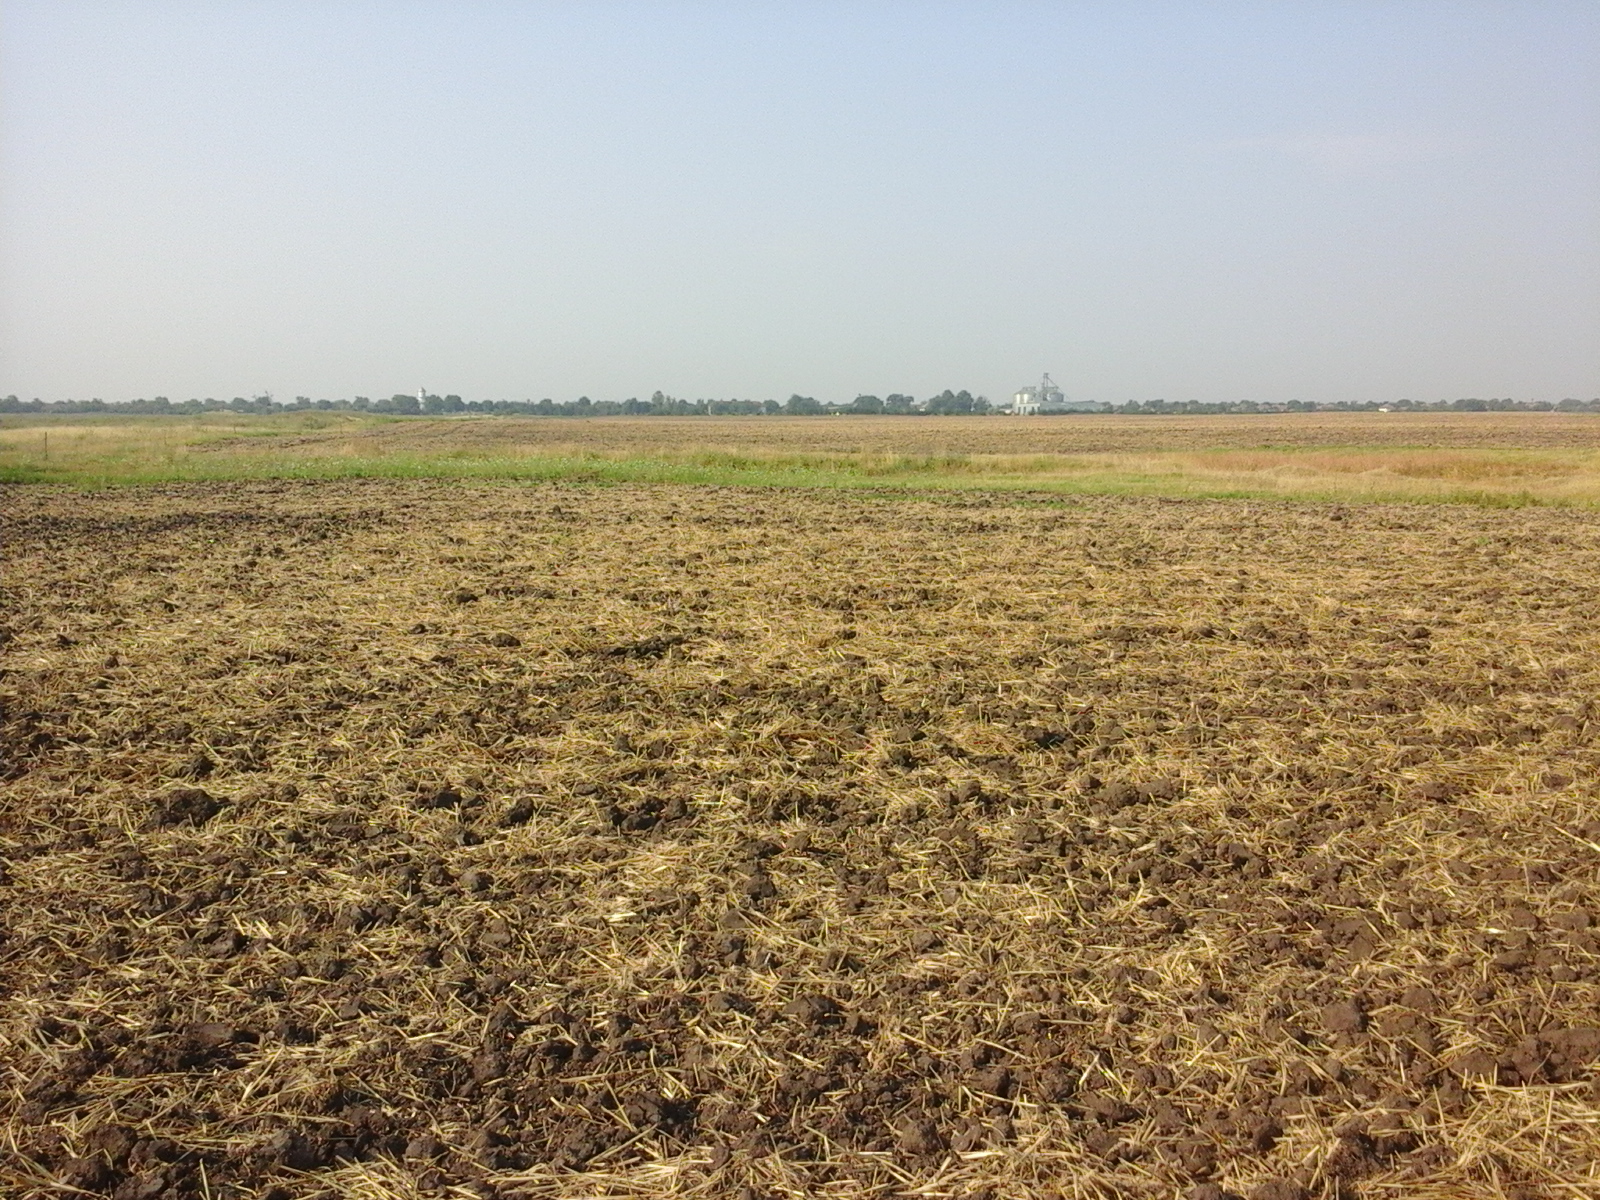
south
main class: Cropland
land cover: Common wheat
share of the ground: 50 - 75 %
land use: Agriculture (excluding fallow land and kitchen gardens)
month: August
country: RO
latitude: 44.0140
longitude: 23.4832
